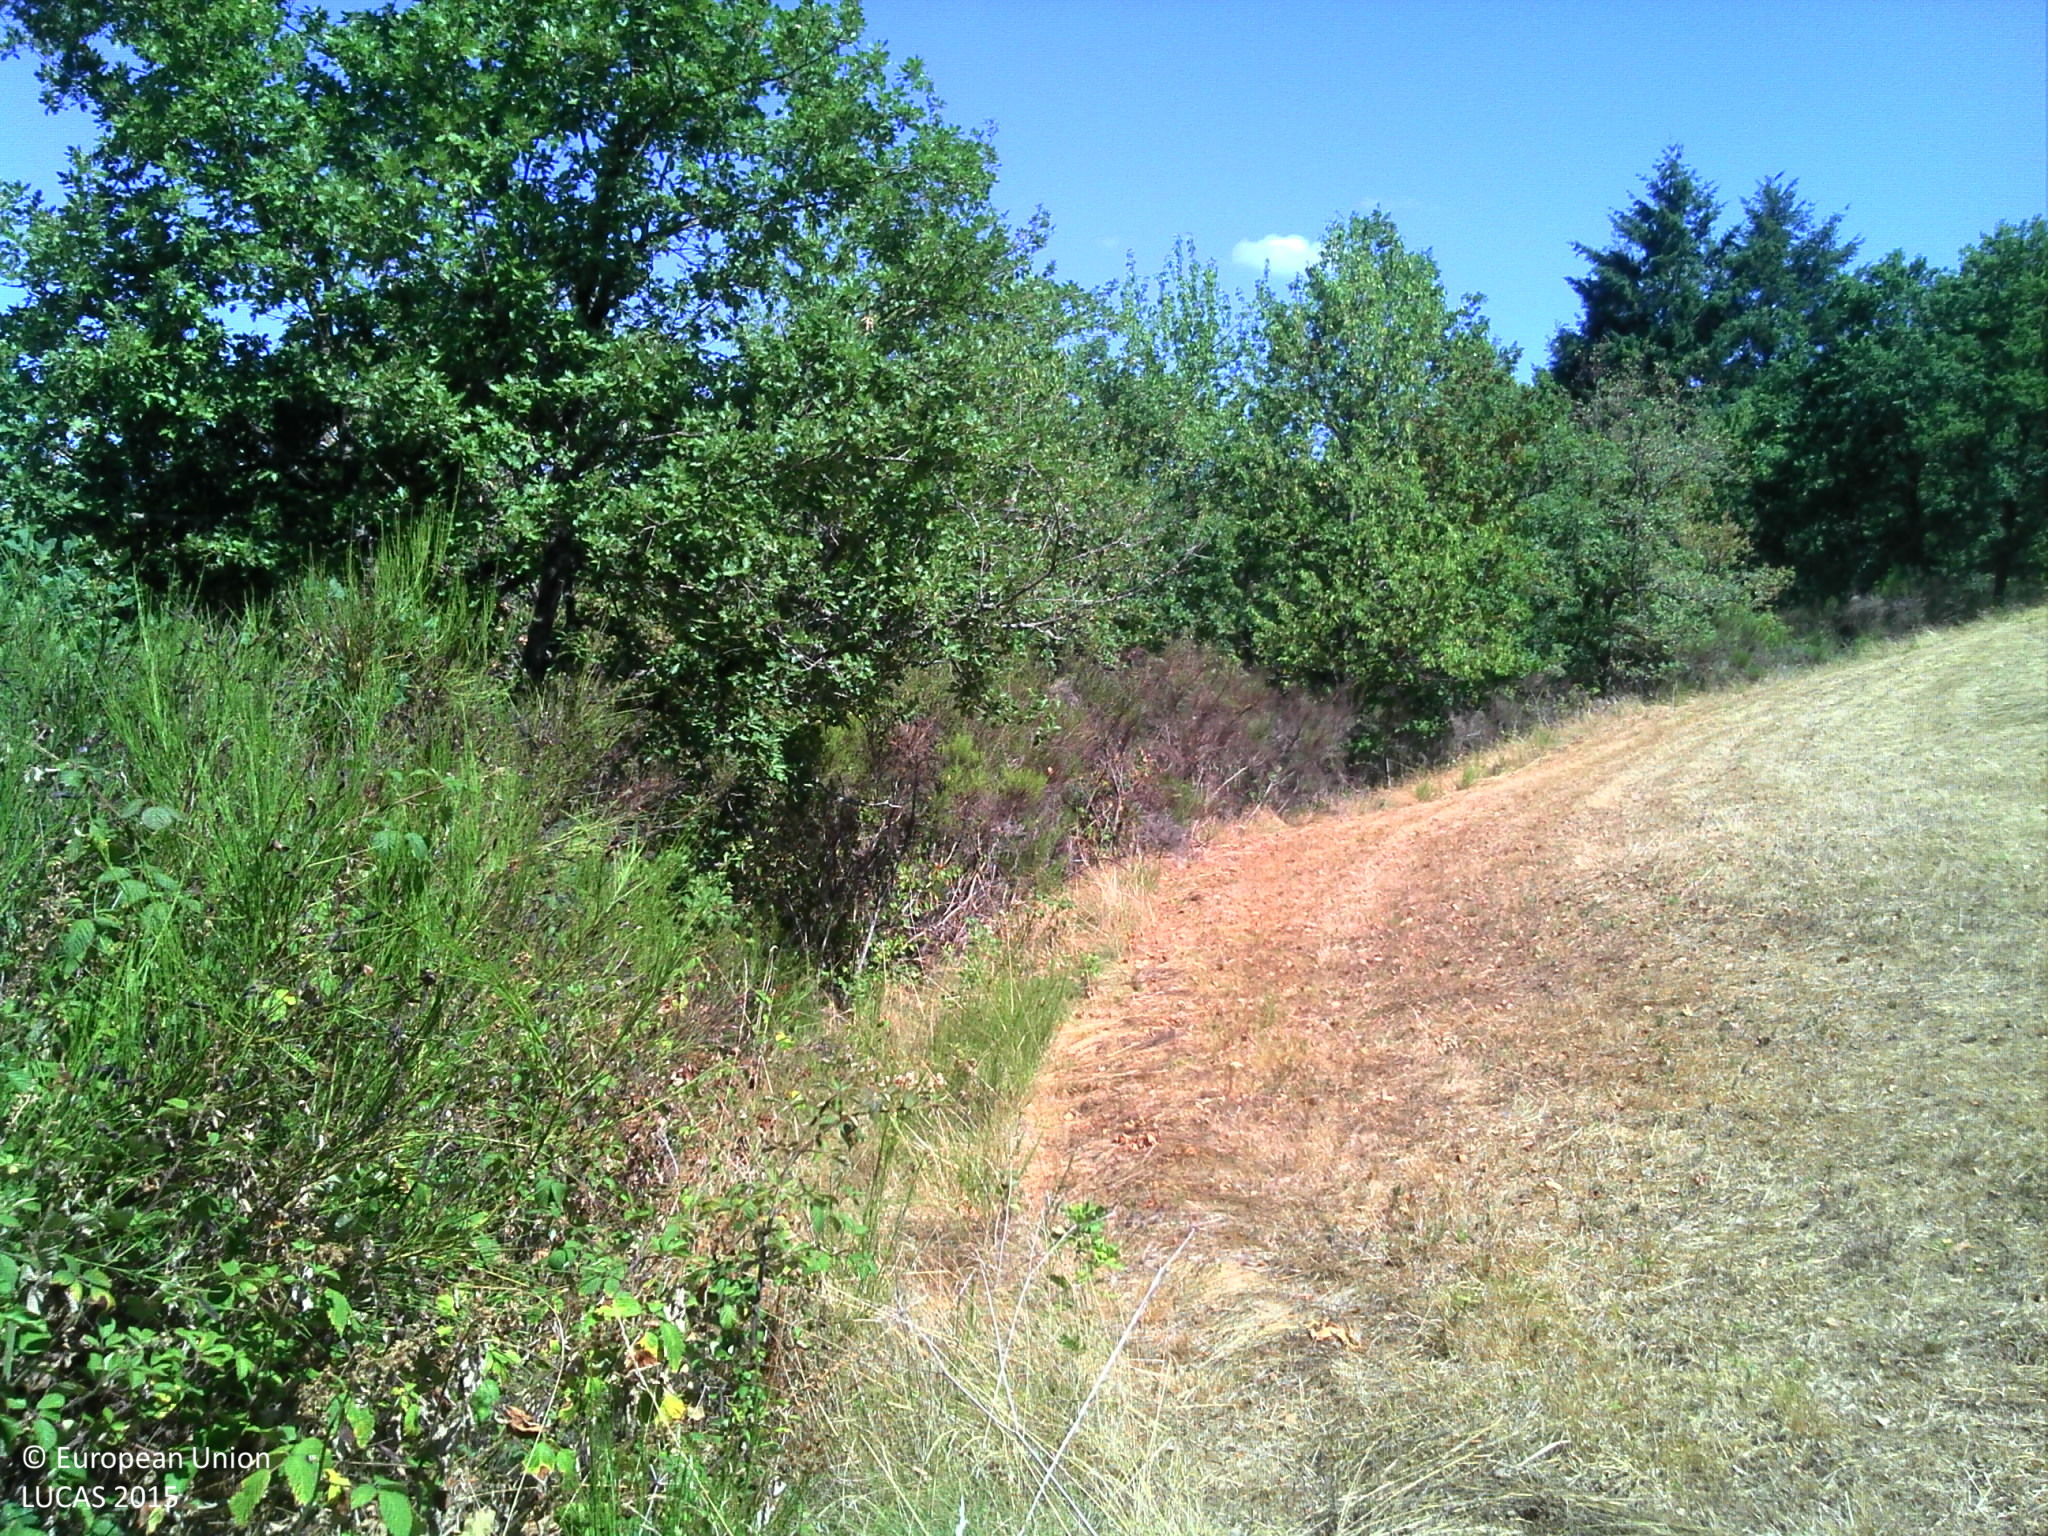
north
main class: Woodland
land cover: Broadleaved woodland
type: mesophytic deciduous forest
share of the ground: > 75 %
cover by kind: broadleaved forest trees 80 %, herbaceous plants 20 %
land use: Semi-natural and natural areas not in use
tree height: < 5 m
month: July
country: FR
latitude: 45.9413
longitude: 4.5465
